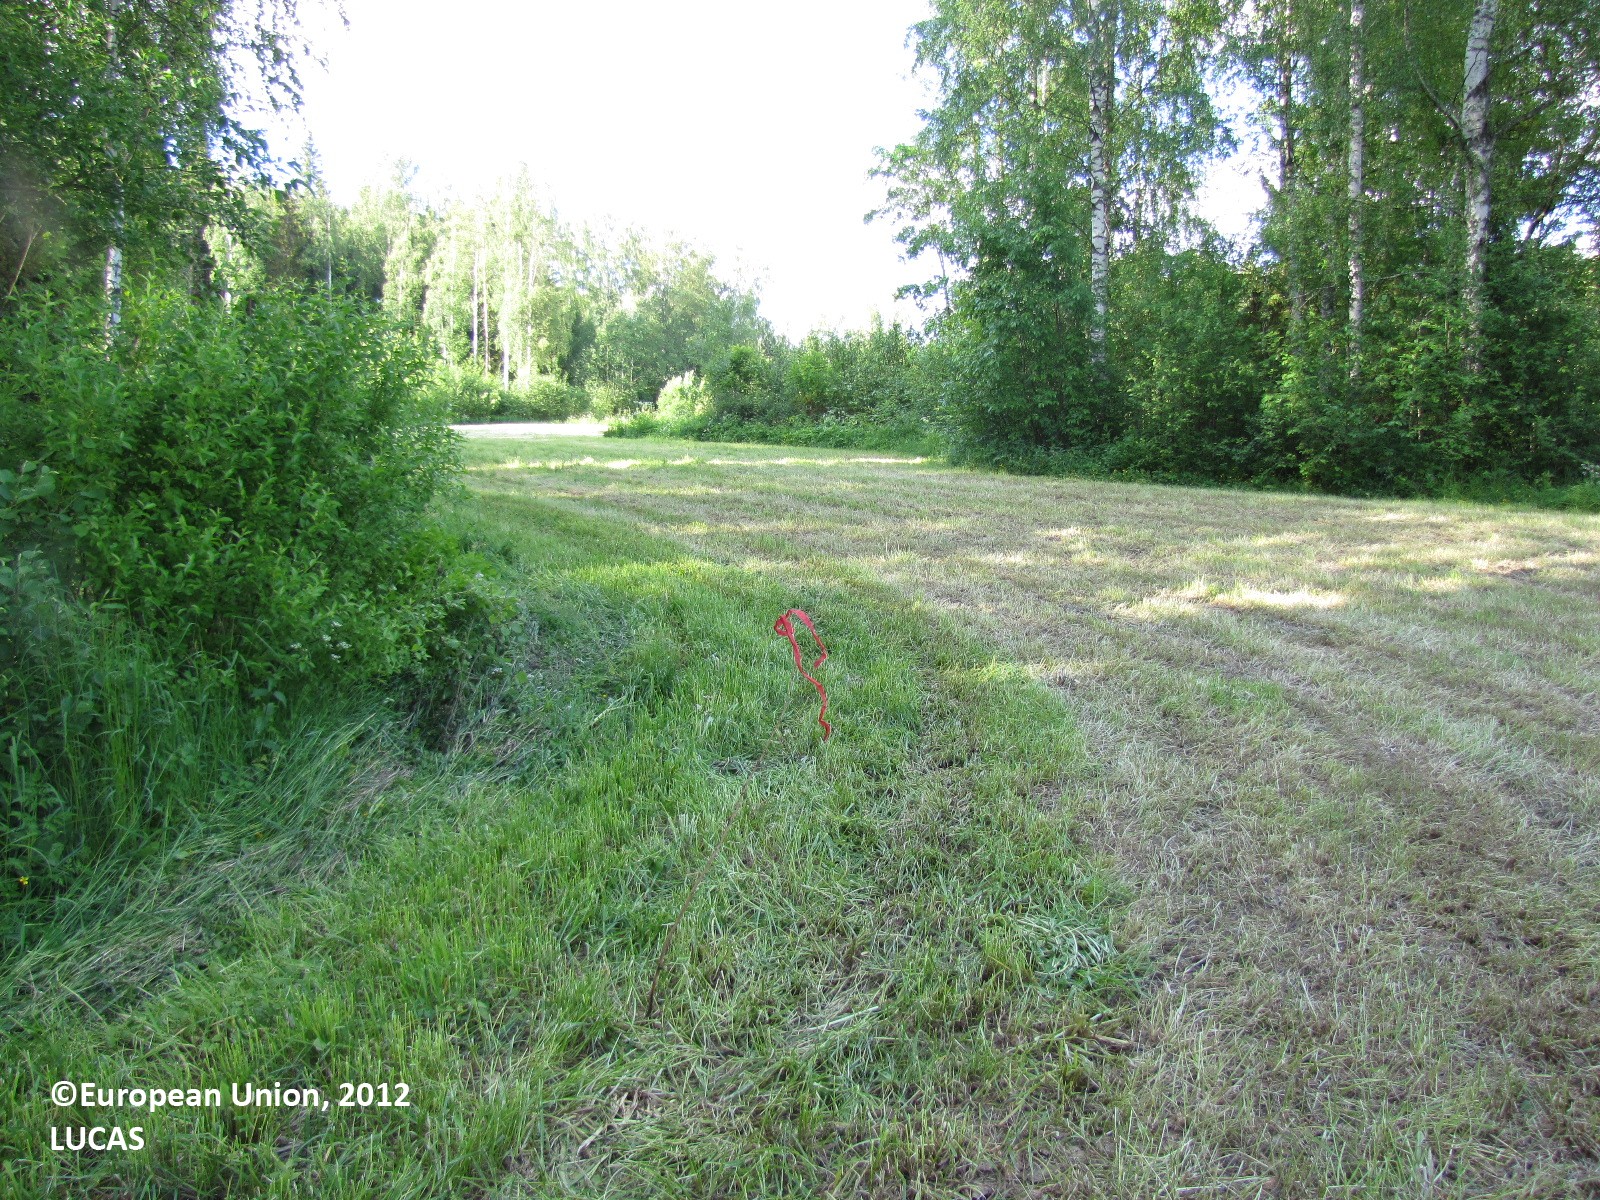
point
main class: Cropland
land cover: Temporary grasslands
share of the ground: 50 - 75 %
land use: Agriculture (excluding fallow land and kitchen gardens)
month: June
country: FI
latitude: 61.4018
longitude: 24.3863
